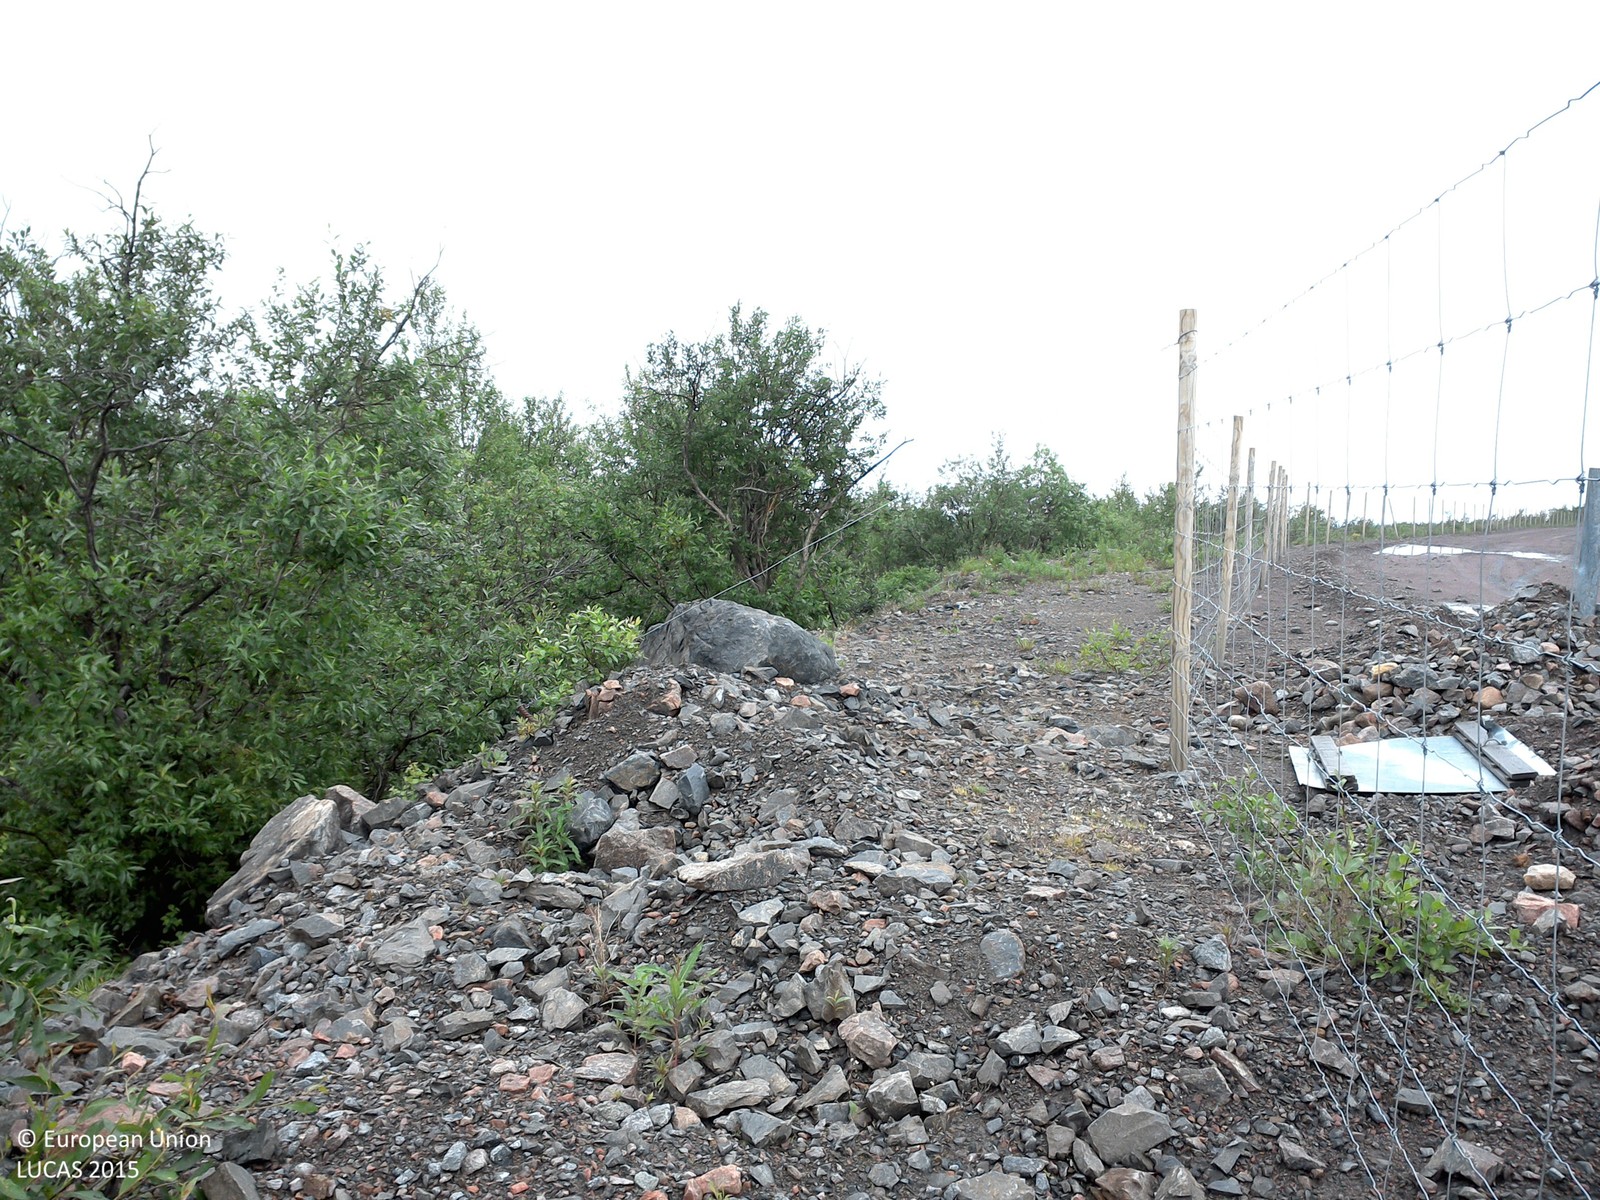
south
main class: Woodland
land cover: Broadleaved woodland
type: boreal forest
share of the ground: 25 - 50 %
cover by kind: shrubs 60 %, broadleaved forest trees 40 %
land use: Mining and quarrying
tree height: < 5 m
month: August
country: SE
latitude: 67.8138
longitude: 20.2147
